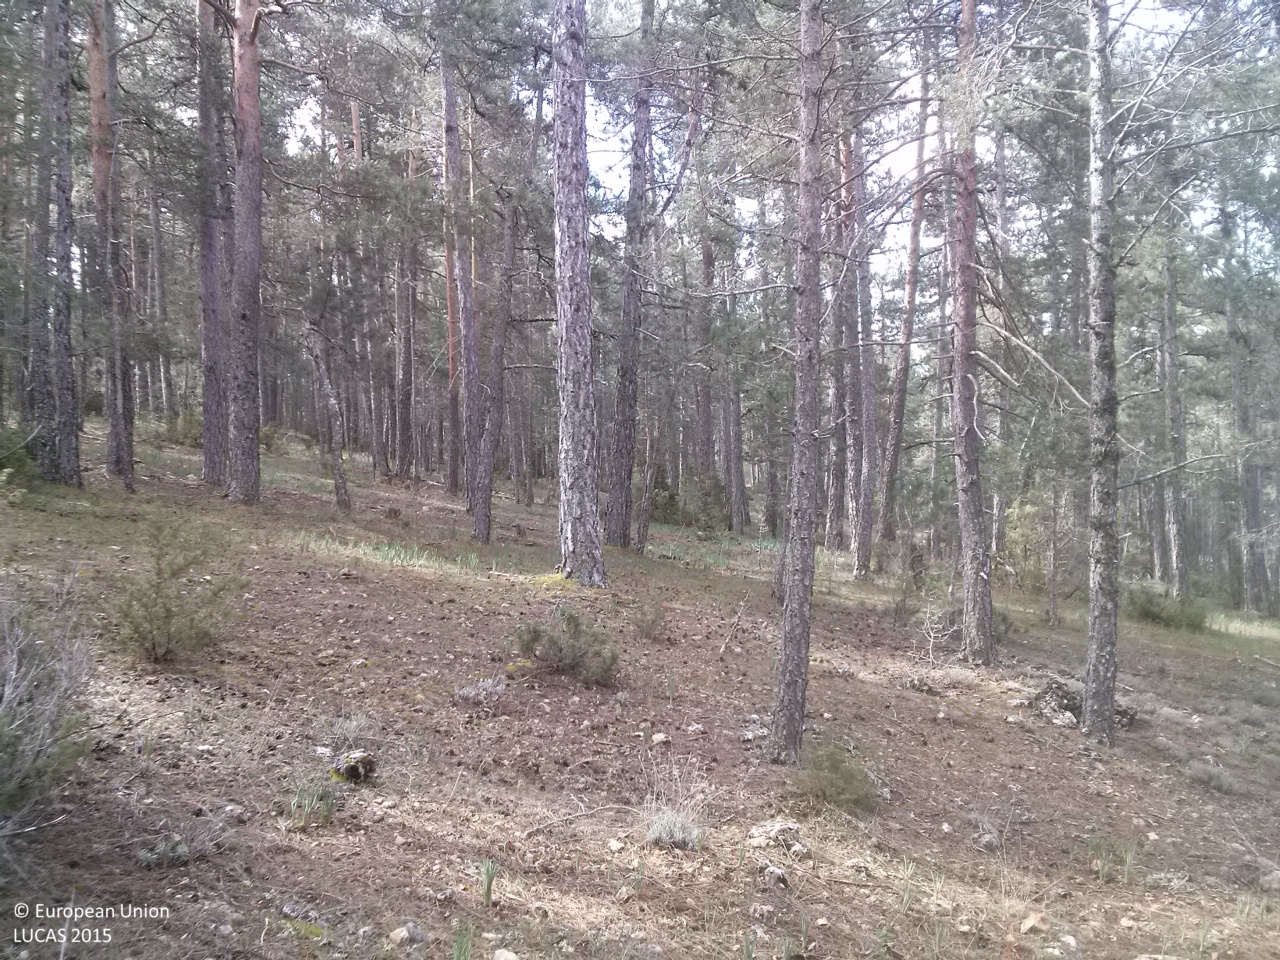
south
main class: Woodland
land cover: Pine dominated coniferous woodland
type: coniferous forest of the mediterranean region
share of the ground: 50 - 75 %
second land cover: Grassland without tree/shrub cover
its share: 10 - 25 %
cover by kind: coniferous forest trees 70 %, herbaceous plants 25 %, consolidated bare surface 5 %
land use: Forestry
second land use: Agriculture (excluding fallow land and kitchen gardens)
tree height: > 5 m
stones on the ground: 10 - 25 %
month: April
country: ES
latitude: 40.2525
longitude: -1.9018
